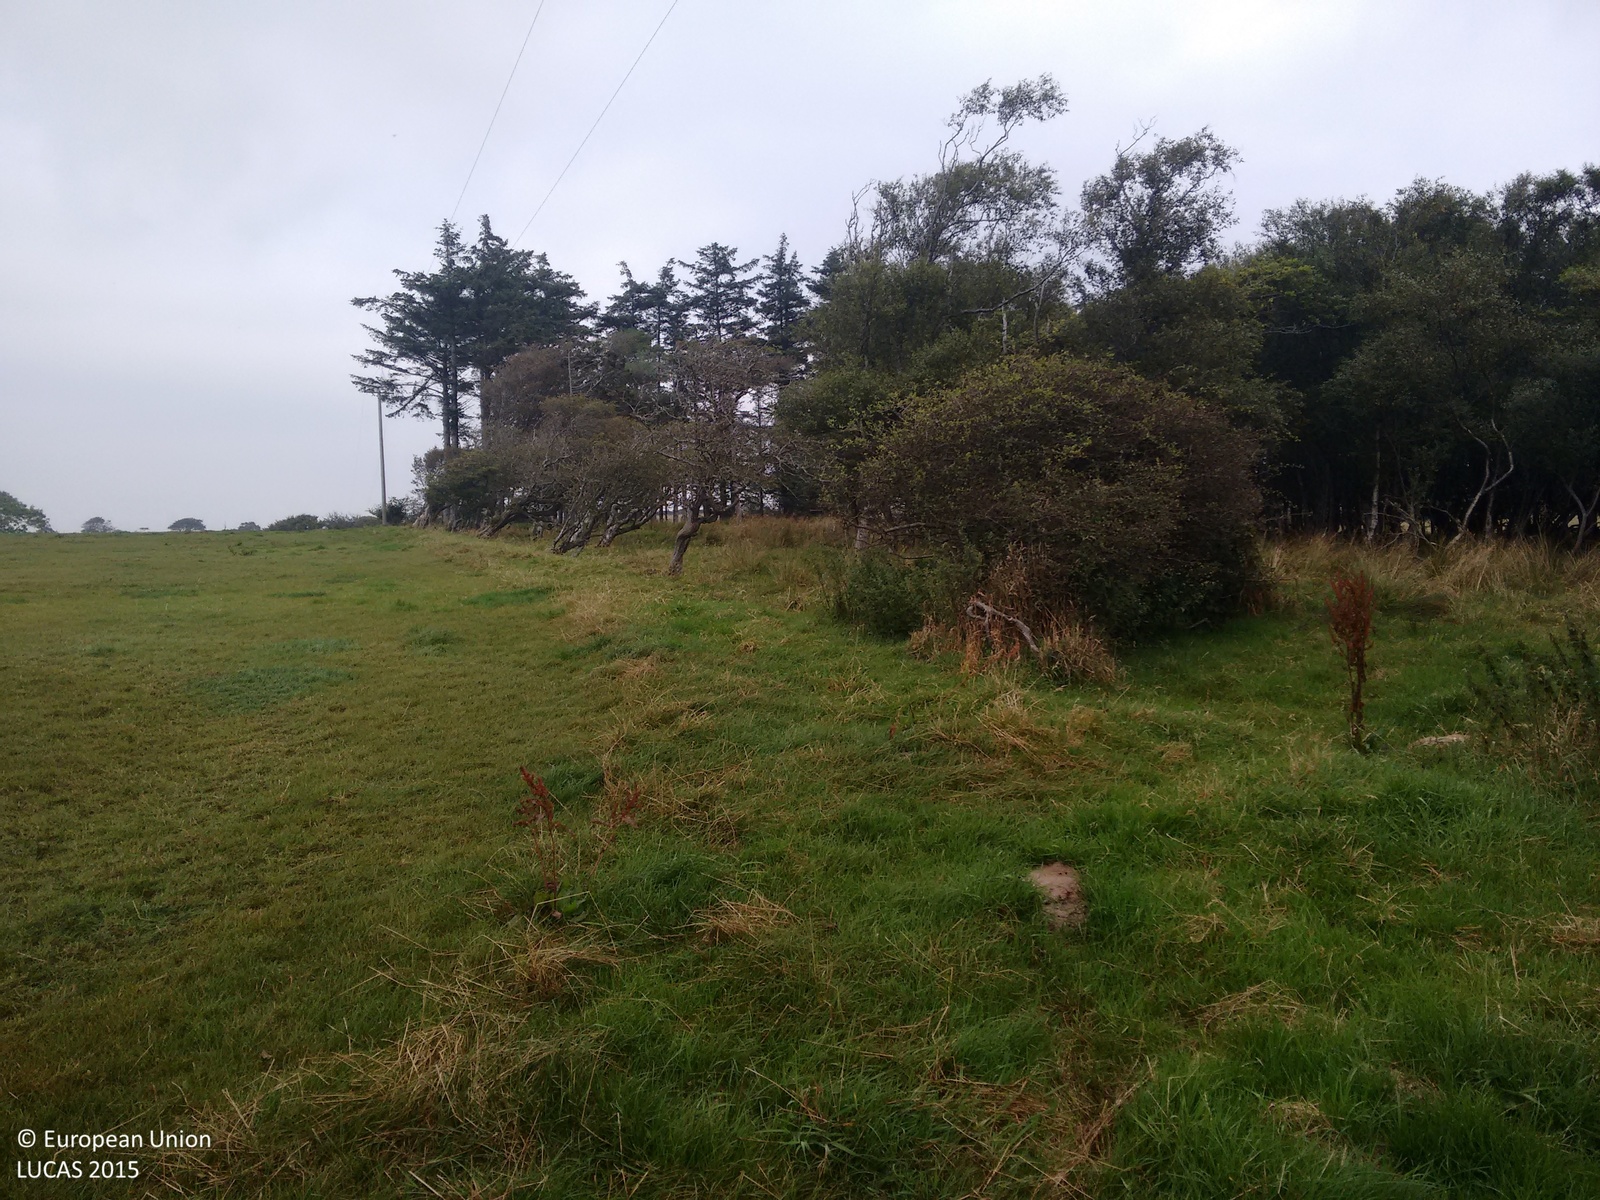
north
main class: Grassland
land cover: Grassland without tree/shrub cover
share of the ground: > 75 %
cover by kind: herbaceous plants 100 %
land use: Agriculture (excluding fallow land and kitchen gardens)
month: September
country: GB
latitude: 55.1876
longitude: -4.8578
